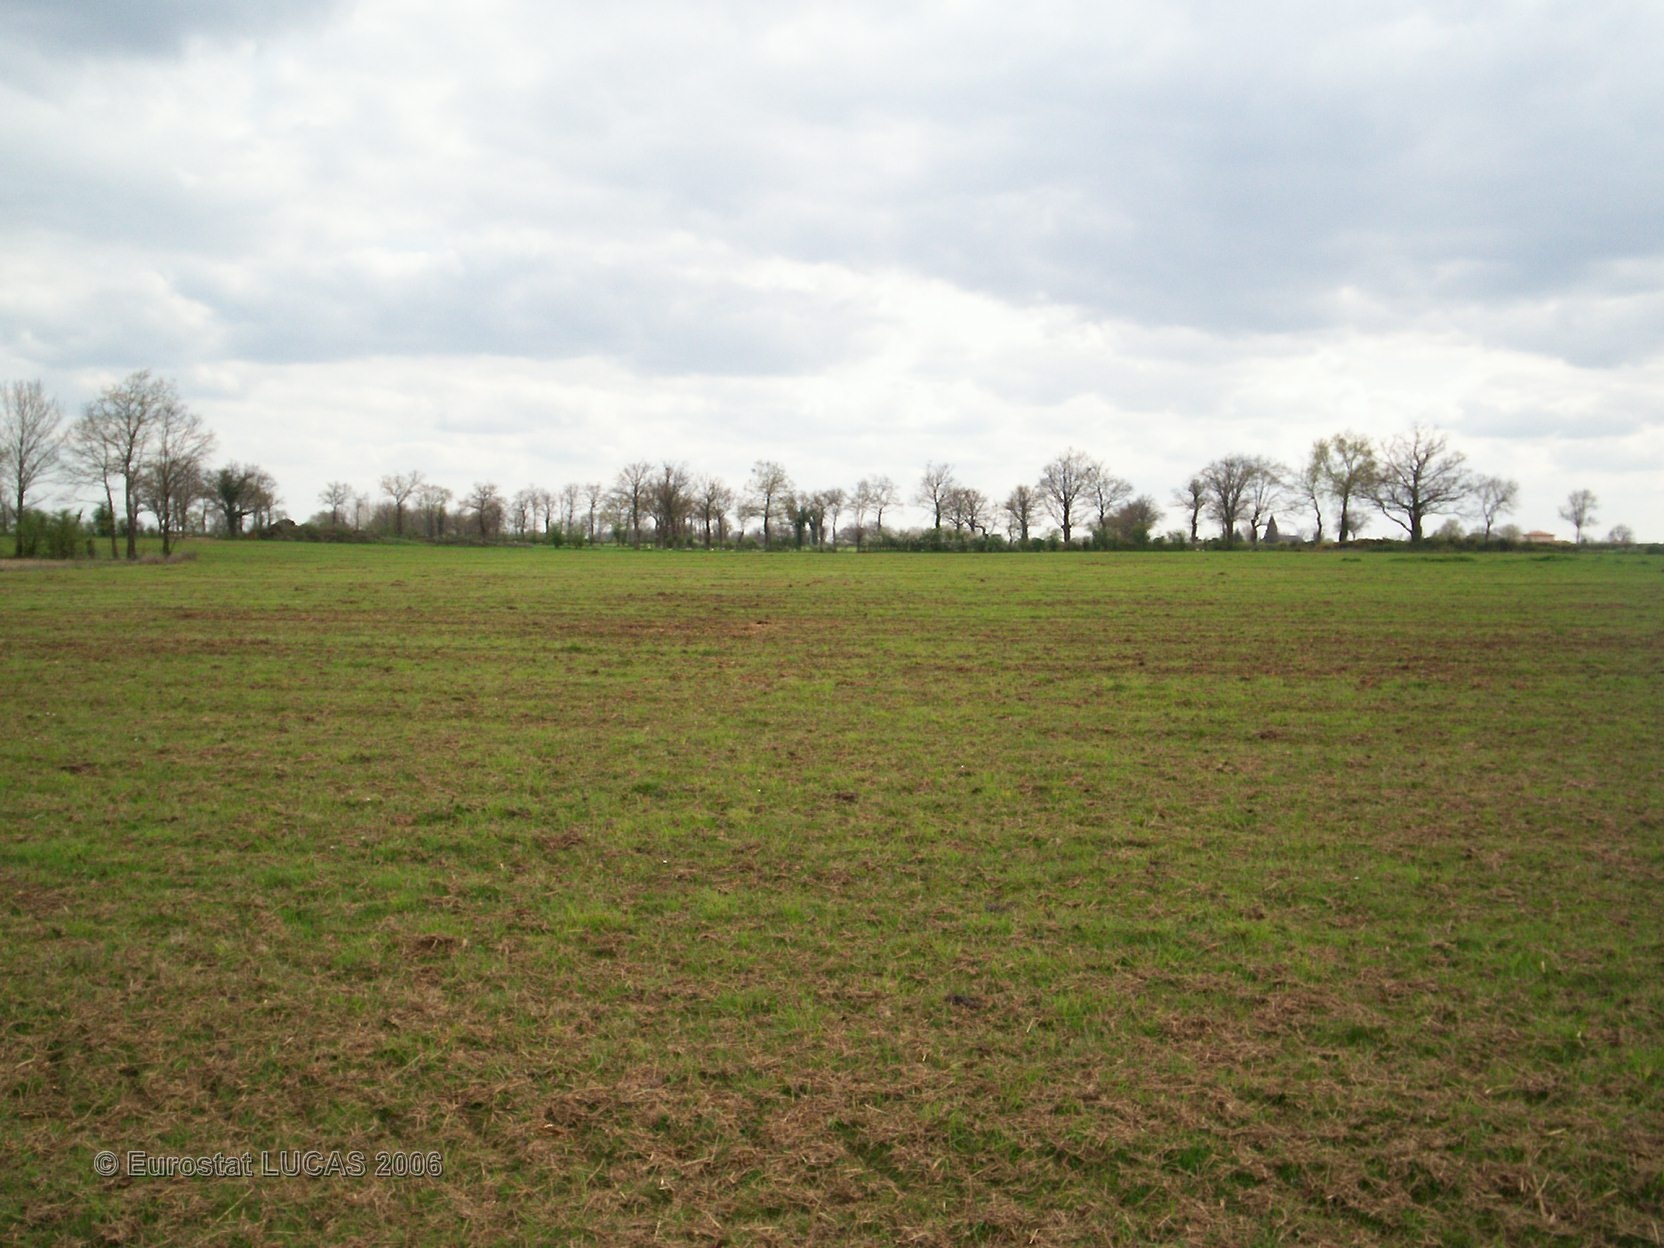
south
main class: Grassland
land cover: Grassland without tree/shrub cover
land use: Agriculture (excluding fallow land and kitchen gardens)
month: April
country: FR
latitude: 46.1135
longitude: 0.5522
